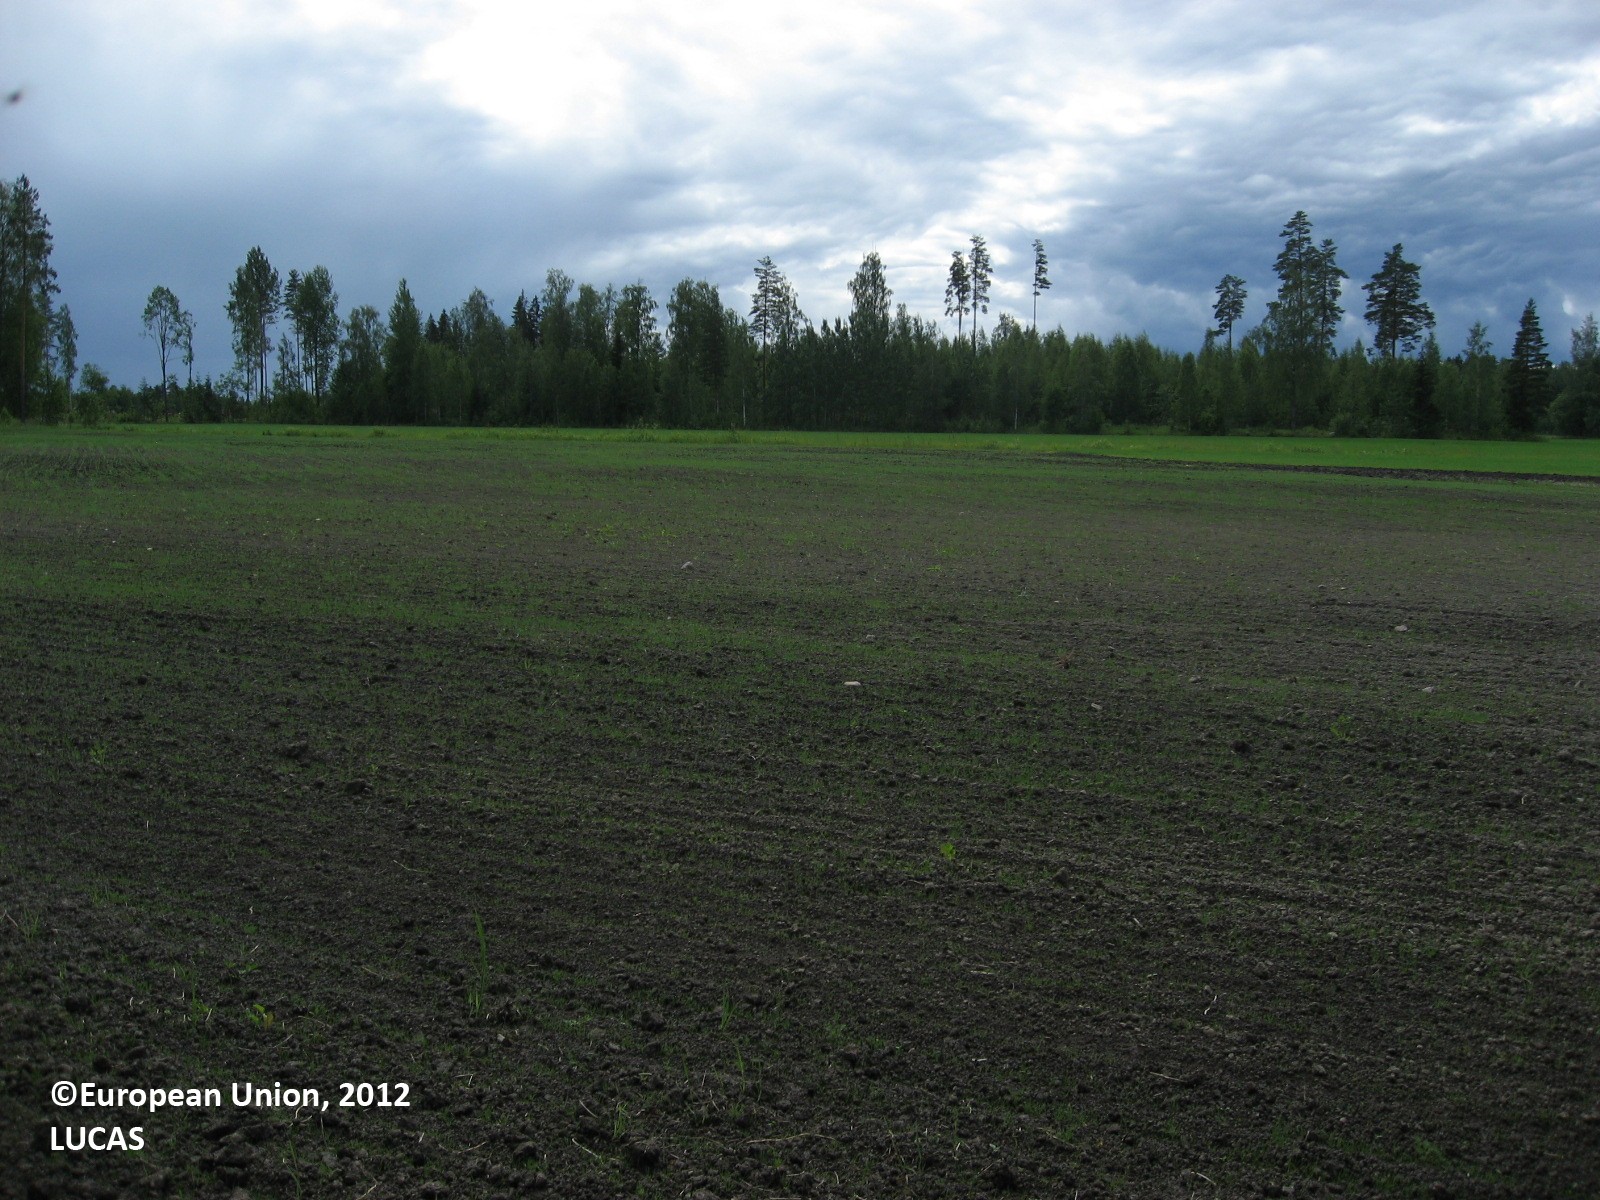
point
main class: Grassland
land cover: Spontaneously vegetated surfaces
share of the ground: < 10 %
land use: Fallow land
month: June
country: FI
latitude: 60.7964
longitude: 26.4116
